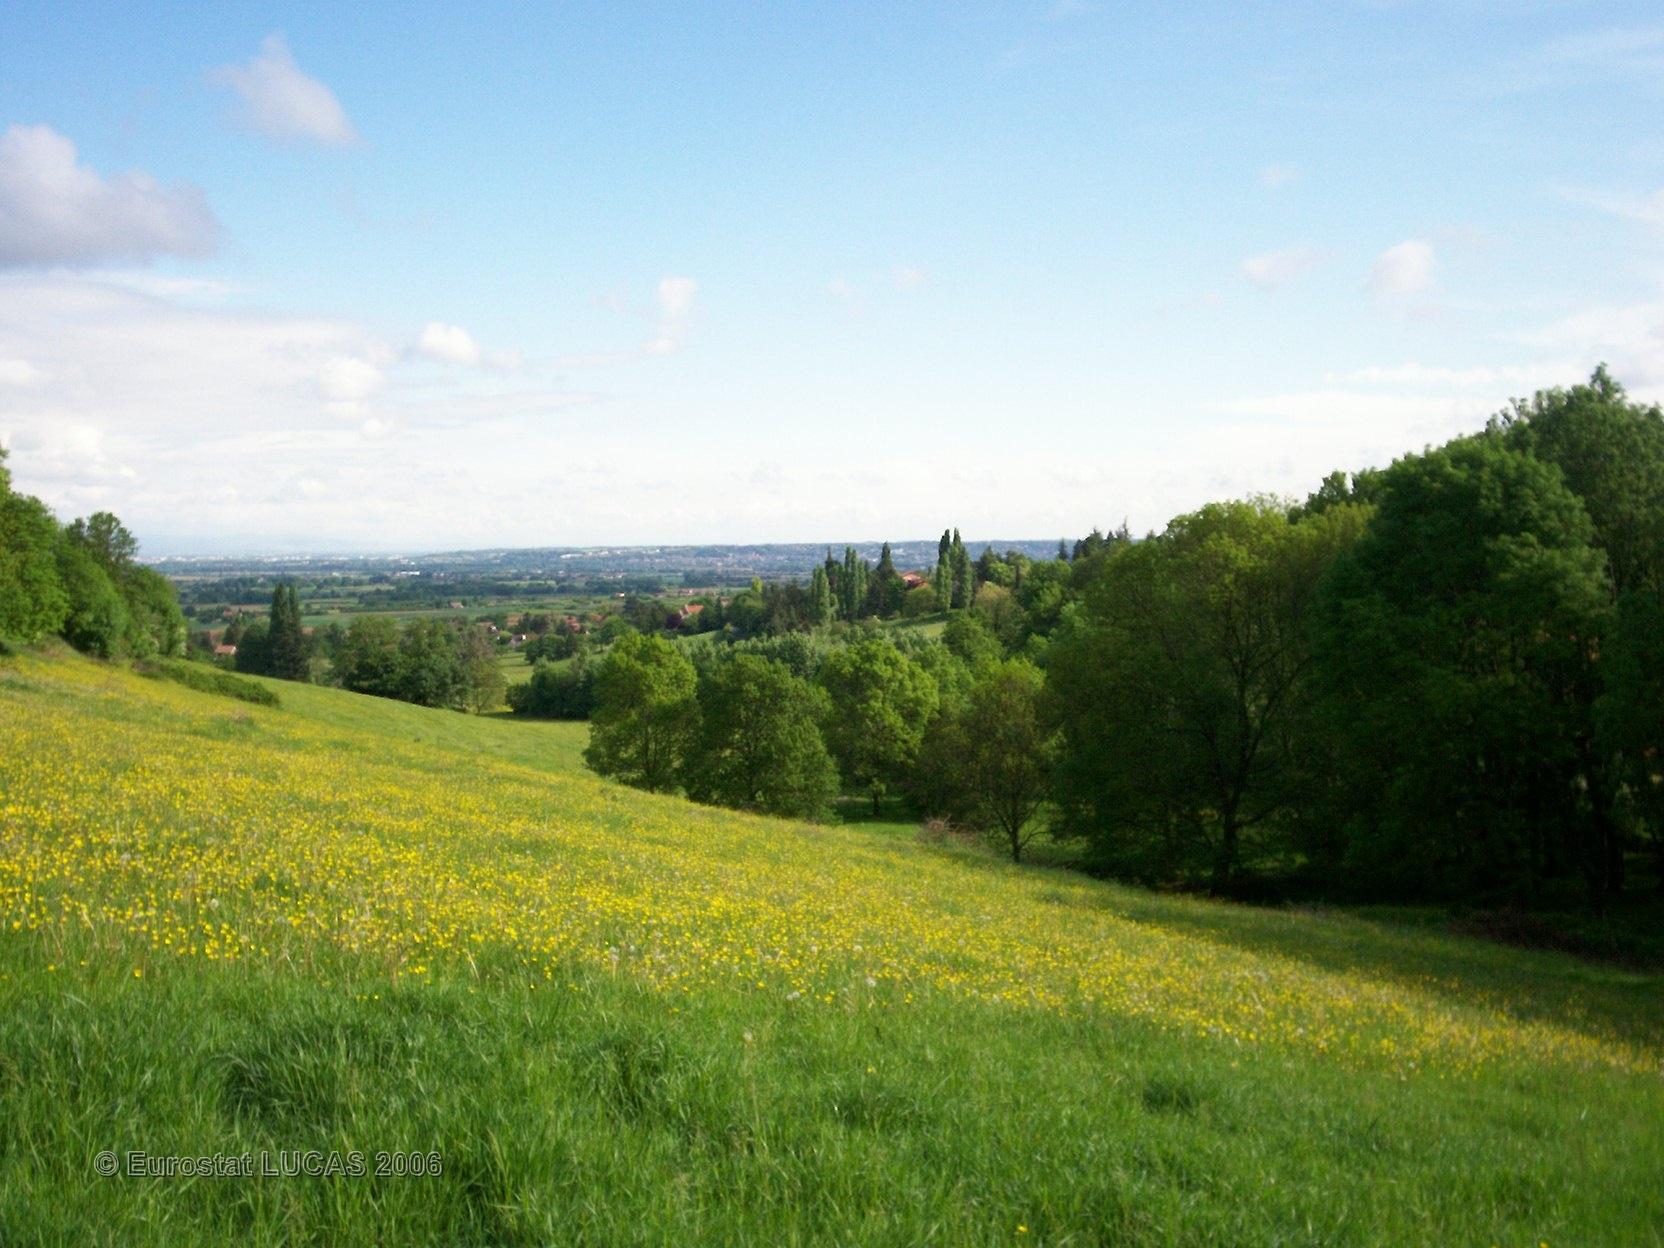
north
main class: Grassland
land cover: Grassland without tree/shrub cover
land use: Agriculture (excluding fallow land and kitchen gardens)
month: May
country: FR
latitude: 45.8618
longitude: 4.7609
